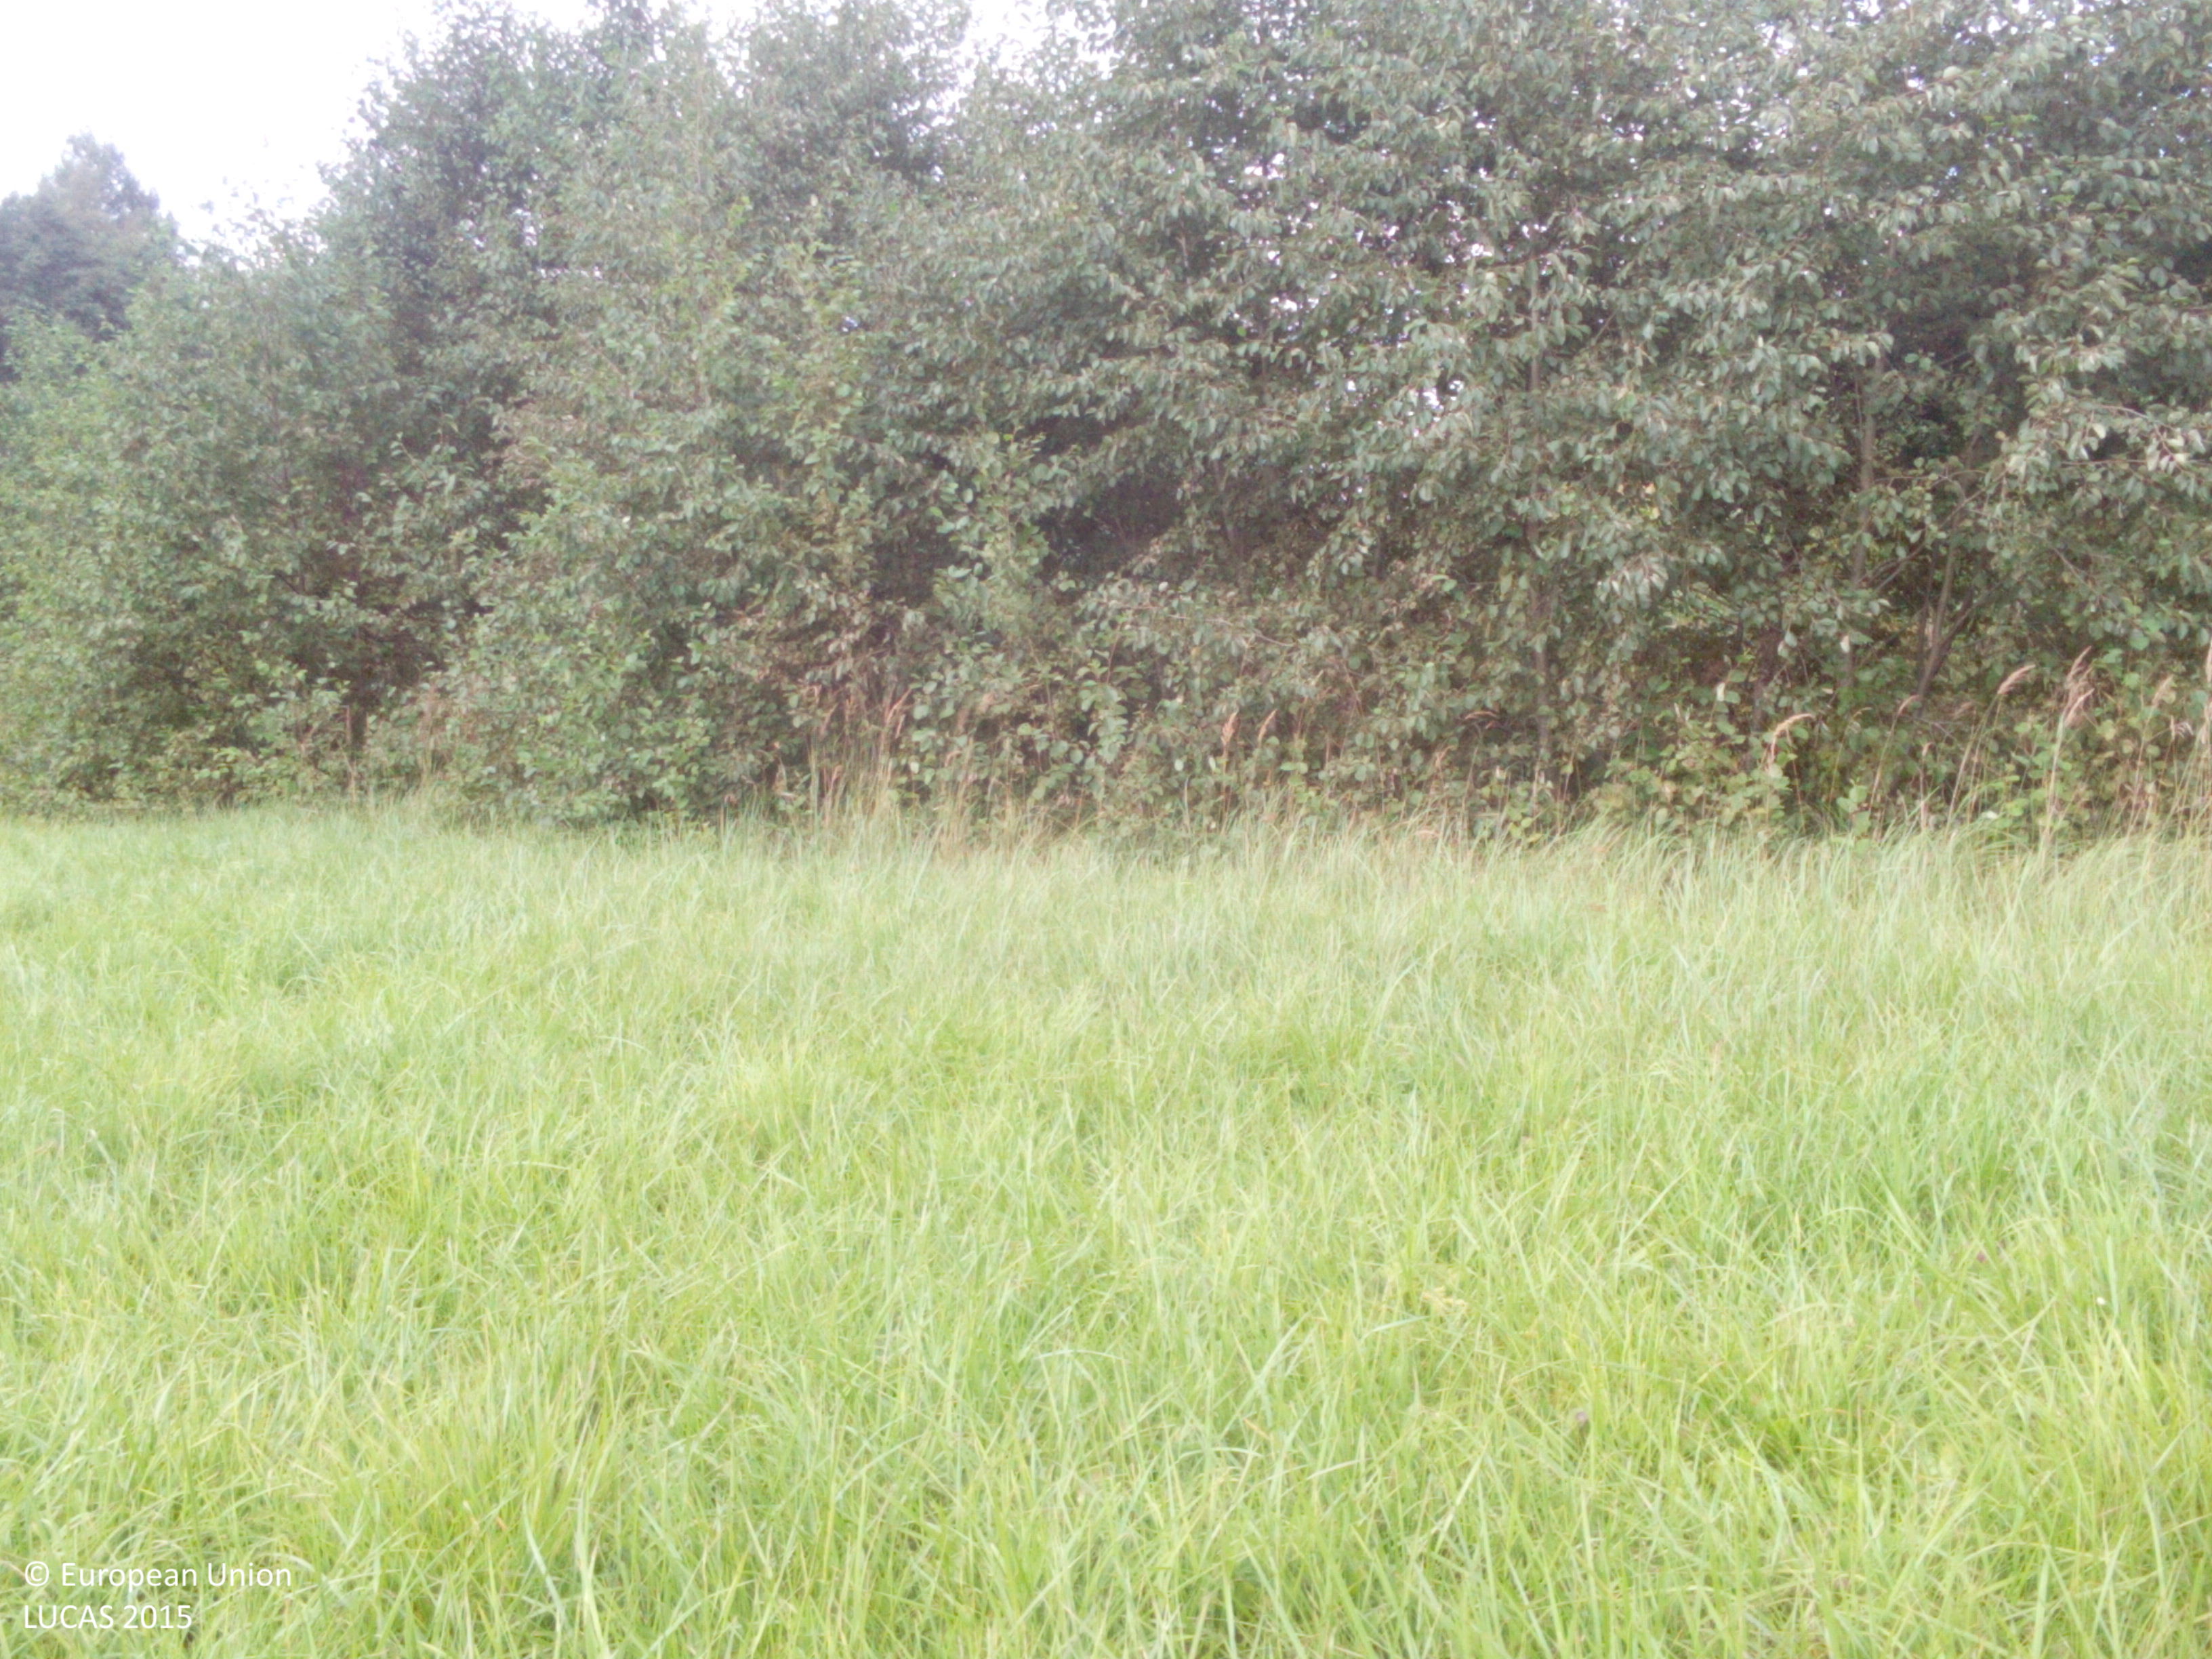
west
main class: Grassland
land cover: Grassland without tree/shrub cover
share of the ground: > 75 %
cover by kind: herbaceous plants 100 %
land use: Agriculture (excluding fallow land and kitchen gardens)
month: August
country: LV
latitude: 56.3043
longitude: 21.3054
